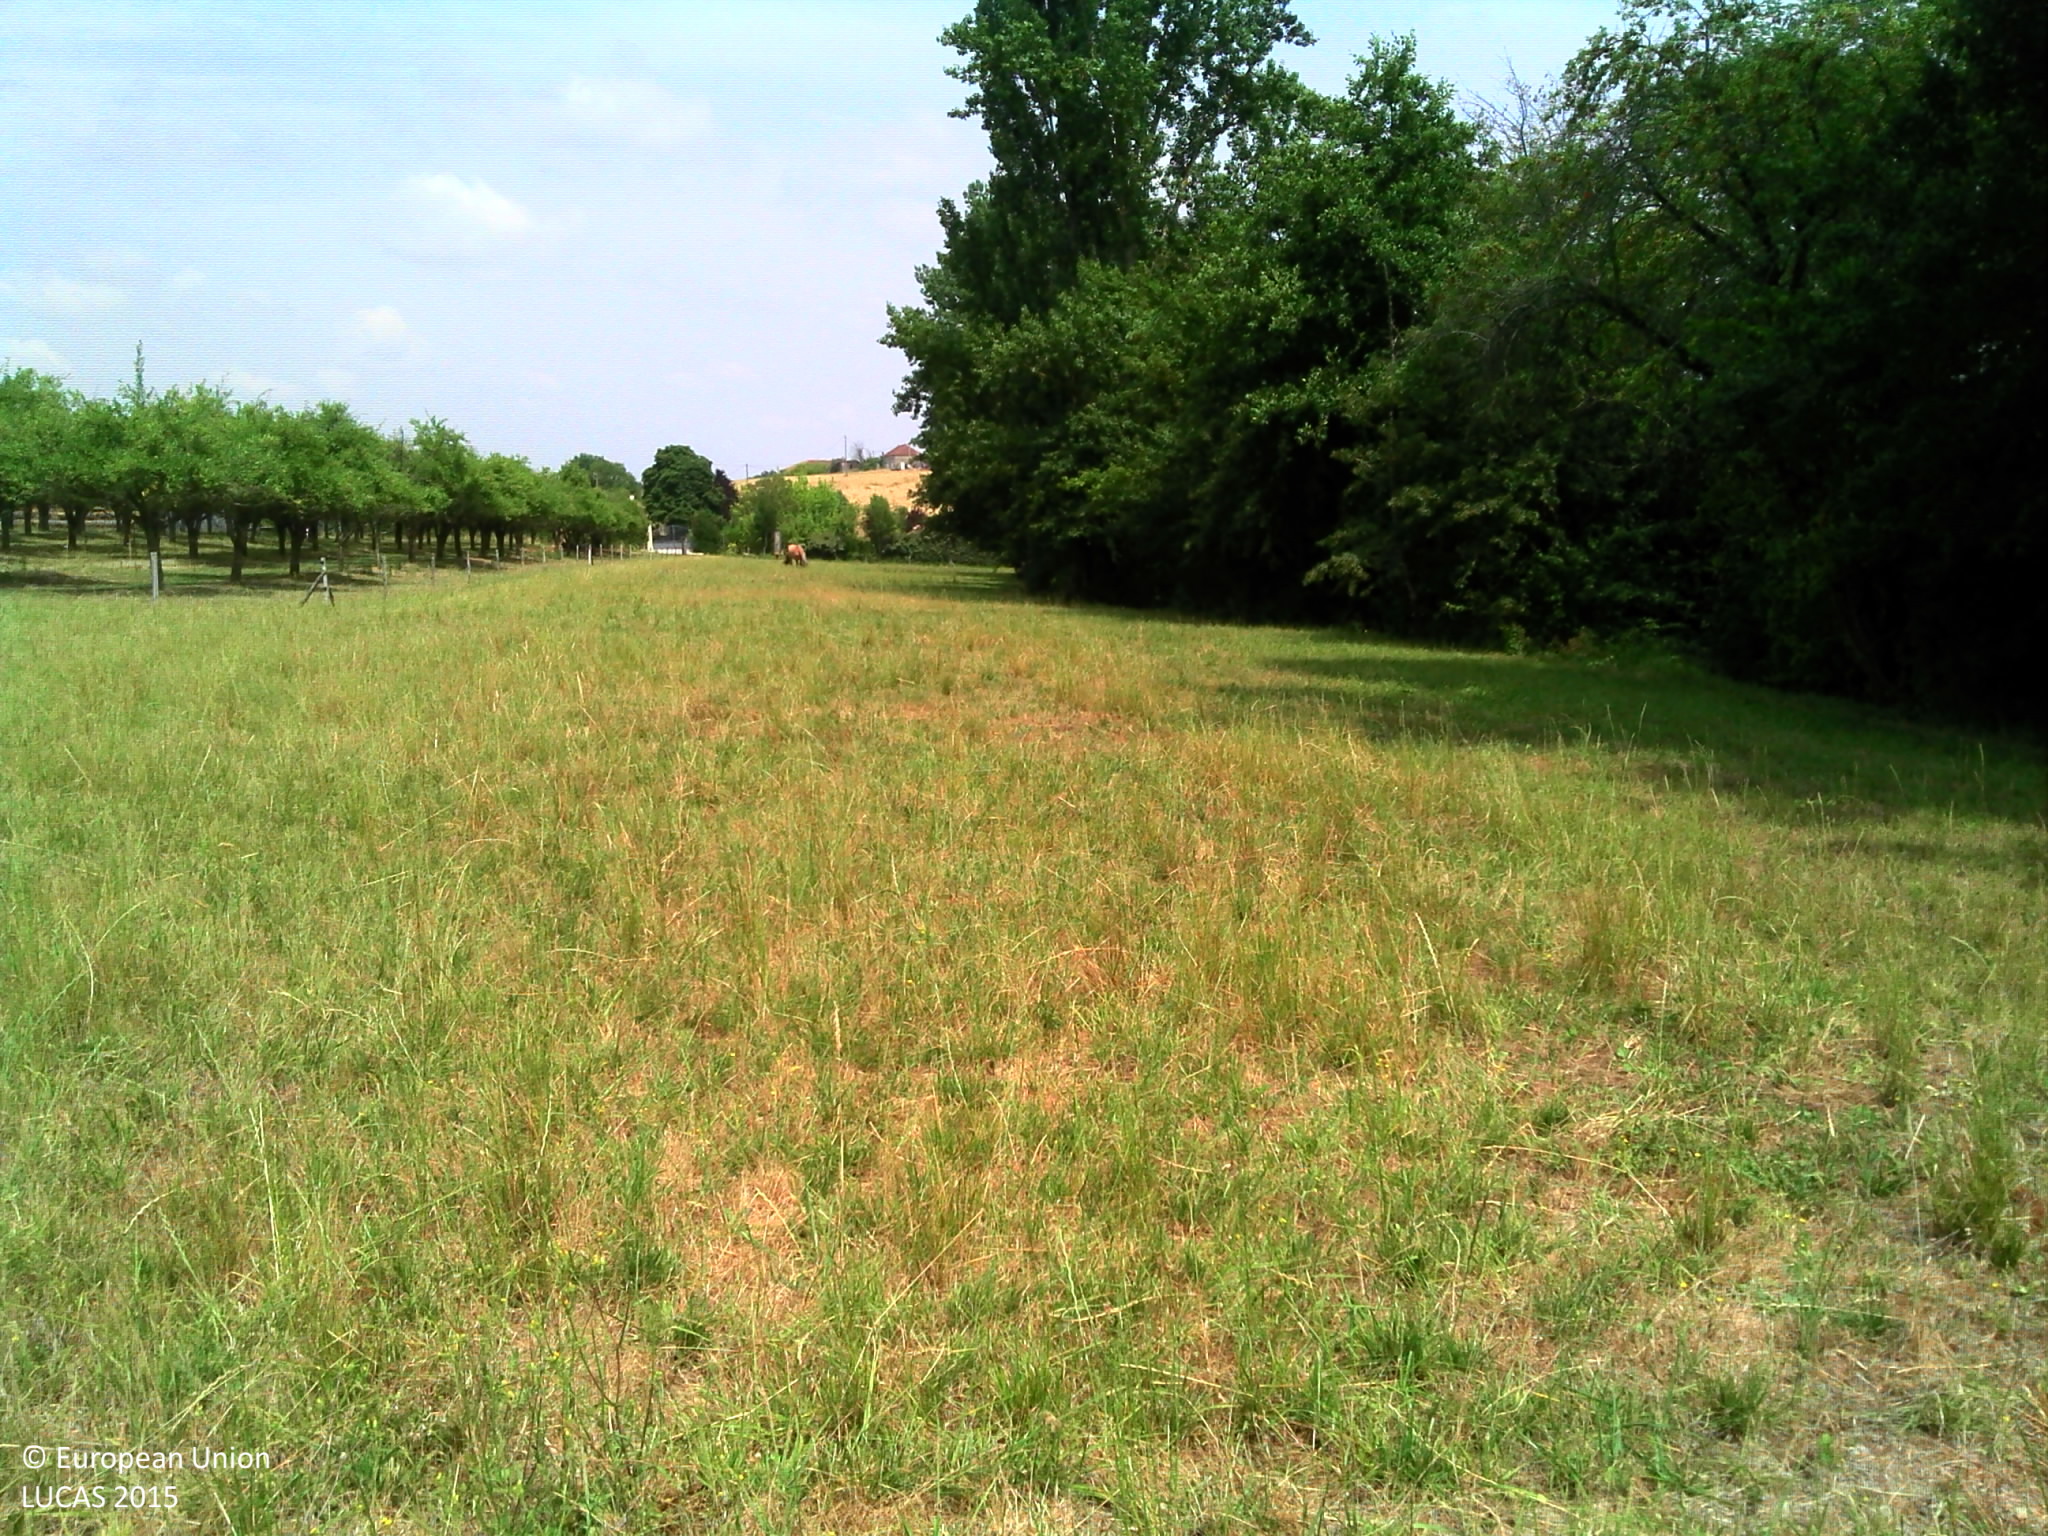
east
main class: Grassland
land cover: Grassland without tree/shrub cover
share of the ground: > 75 %
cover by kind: herbaceous plants 100 %
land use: Agriculture (excluding fallow land and kitchen gardens)
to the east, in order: Grassland without tree/shrub cover; Broadleaved woodland; Rivers and streams; Broadleaved woodland; Other fruit trees and berries; Broadleaved woodland; Rivers and streams; Broadleaved woodland; Grassland with sparse tree/shrub cover
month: July
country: FR
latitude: 44.4185
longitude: 0.8643
